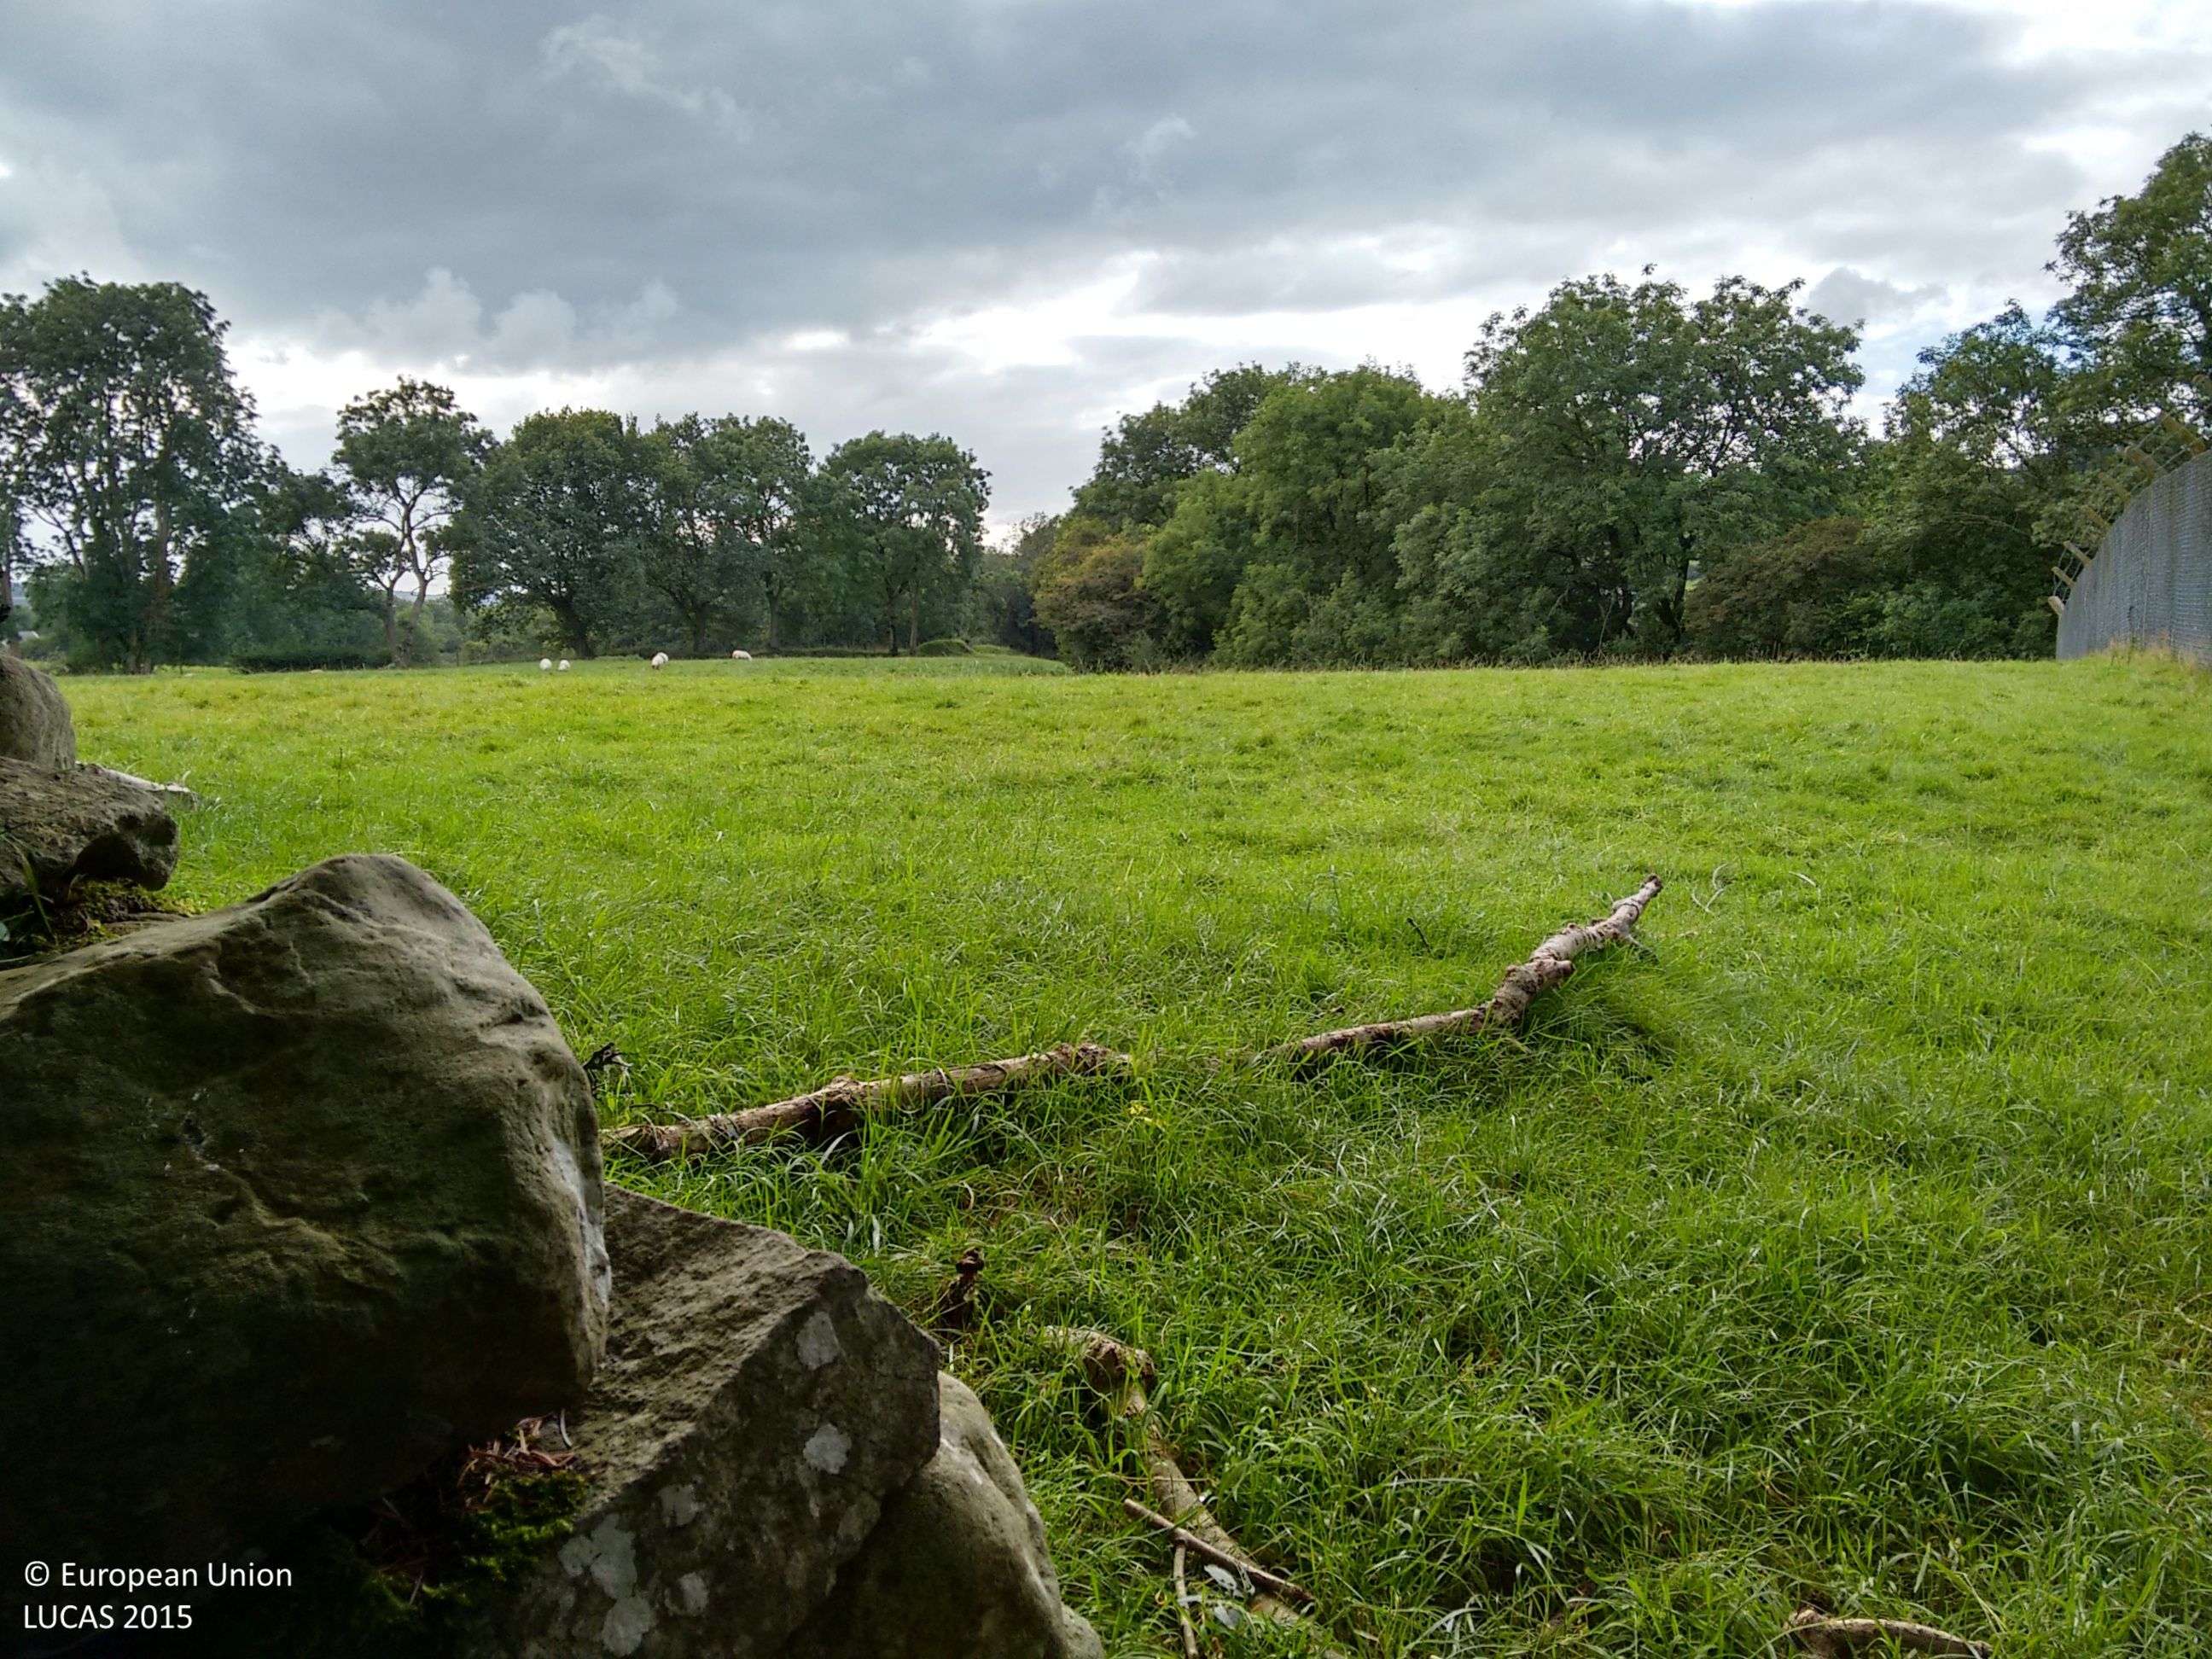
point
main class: Grassland
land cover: Grassland without tree/shrub cover
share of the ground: > 75 %
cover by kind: herbaceous plants 100 %
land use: Agriculture (excluding fallow land and kitchen gardens)
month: September
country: GB
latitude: 52.1214
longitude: -4.0437
